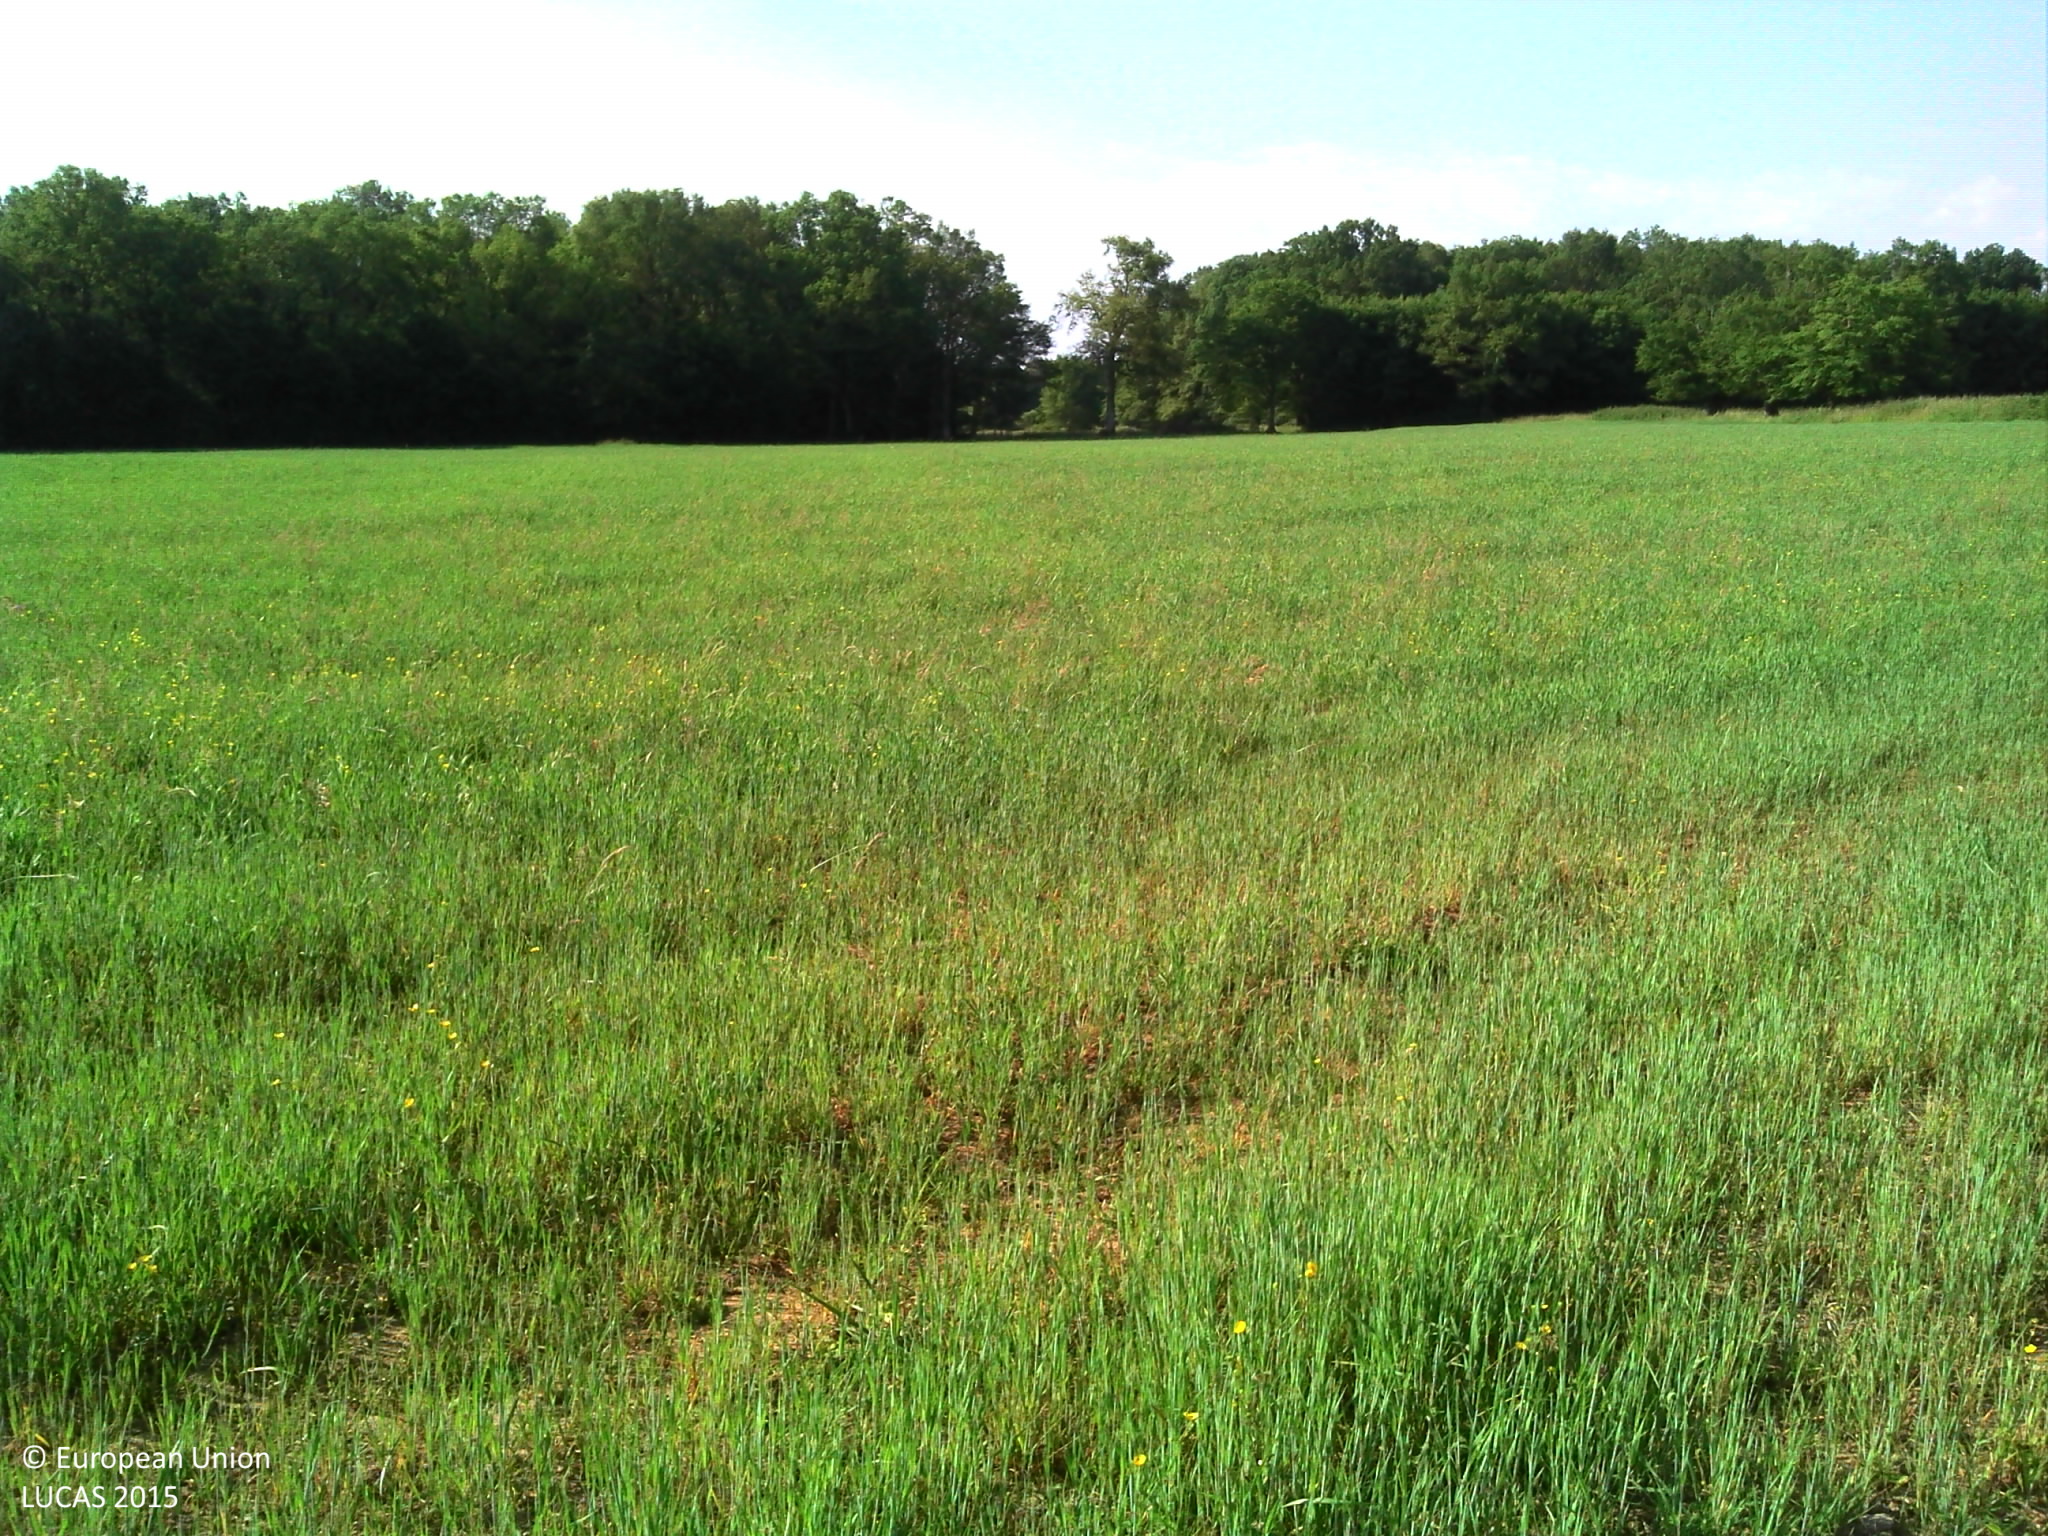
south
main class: Cropland
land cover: Barley
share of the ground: > 75 %
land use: Agriculture (excluding fallow land and kitchen gardens)
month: June
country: FR
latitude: 46.7527
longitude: 2.7035
